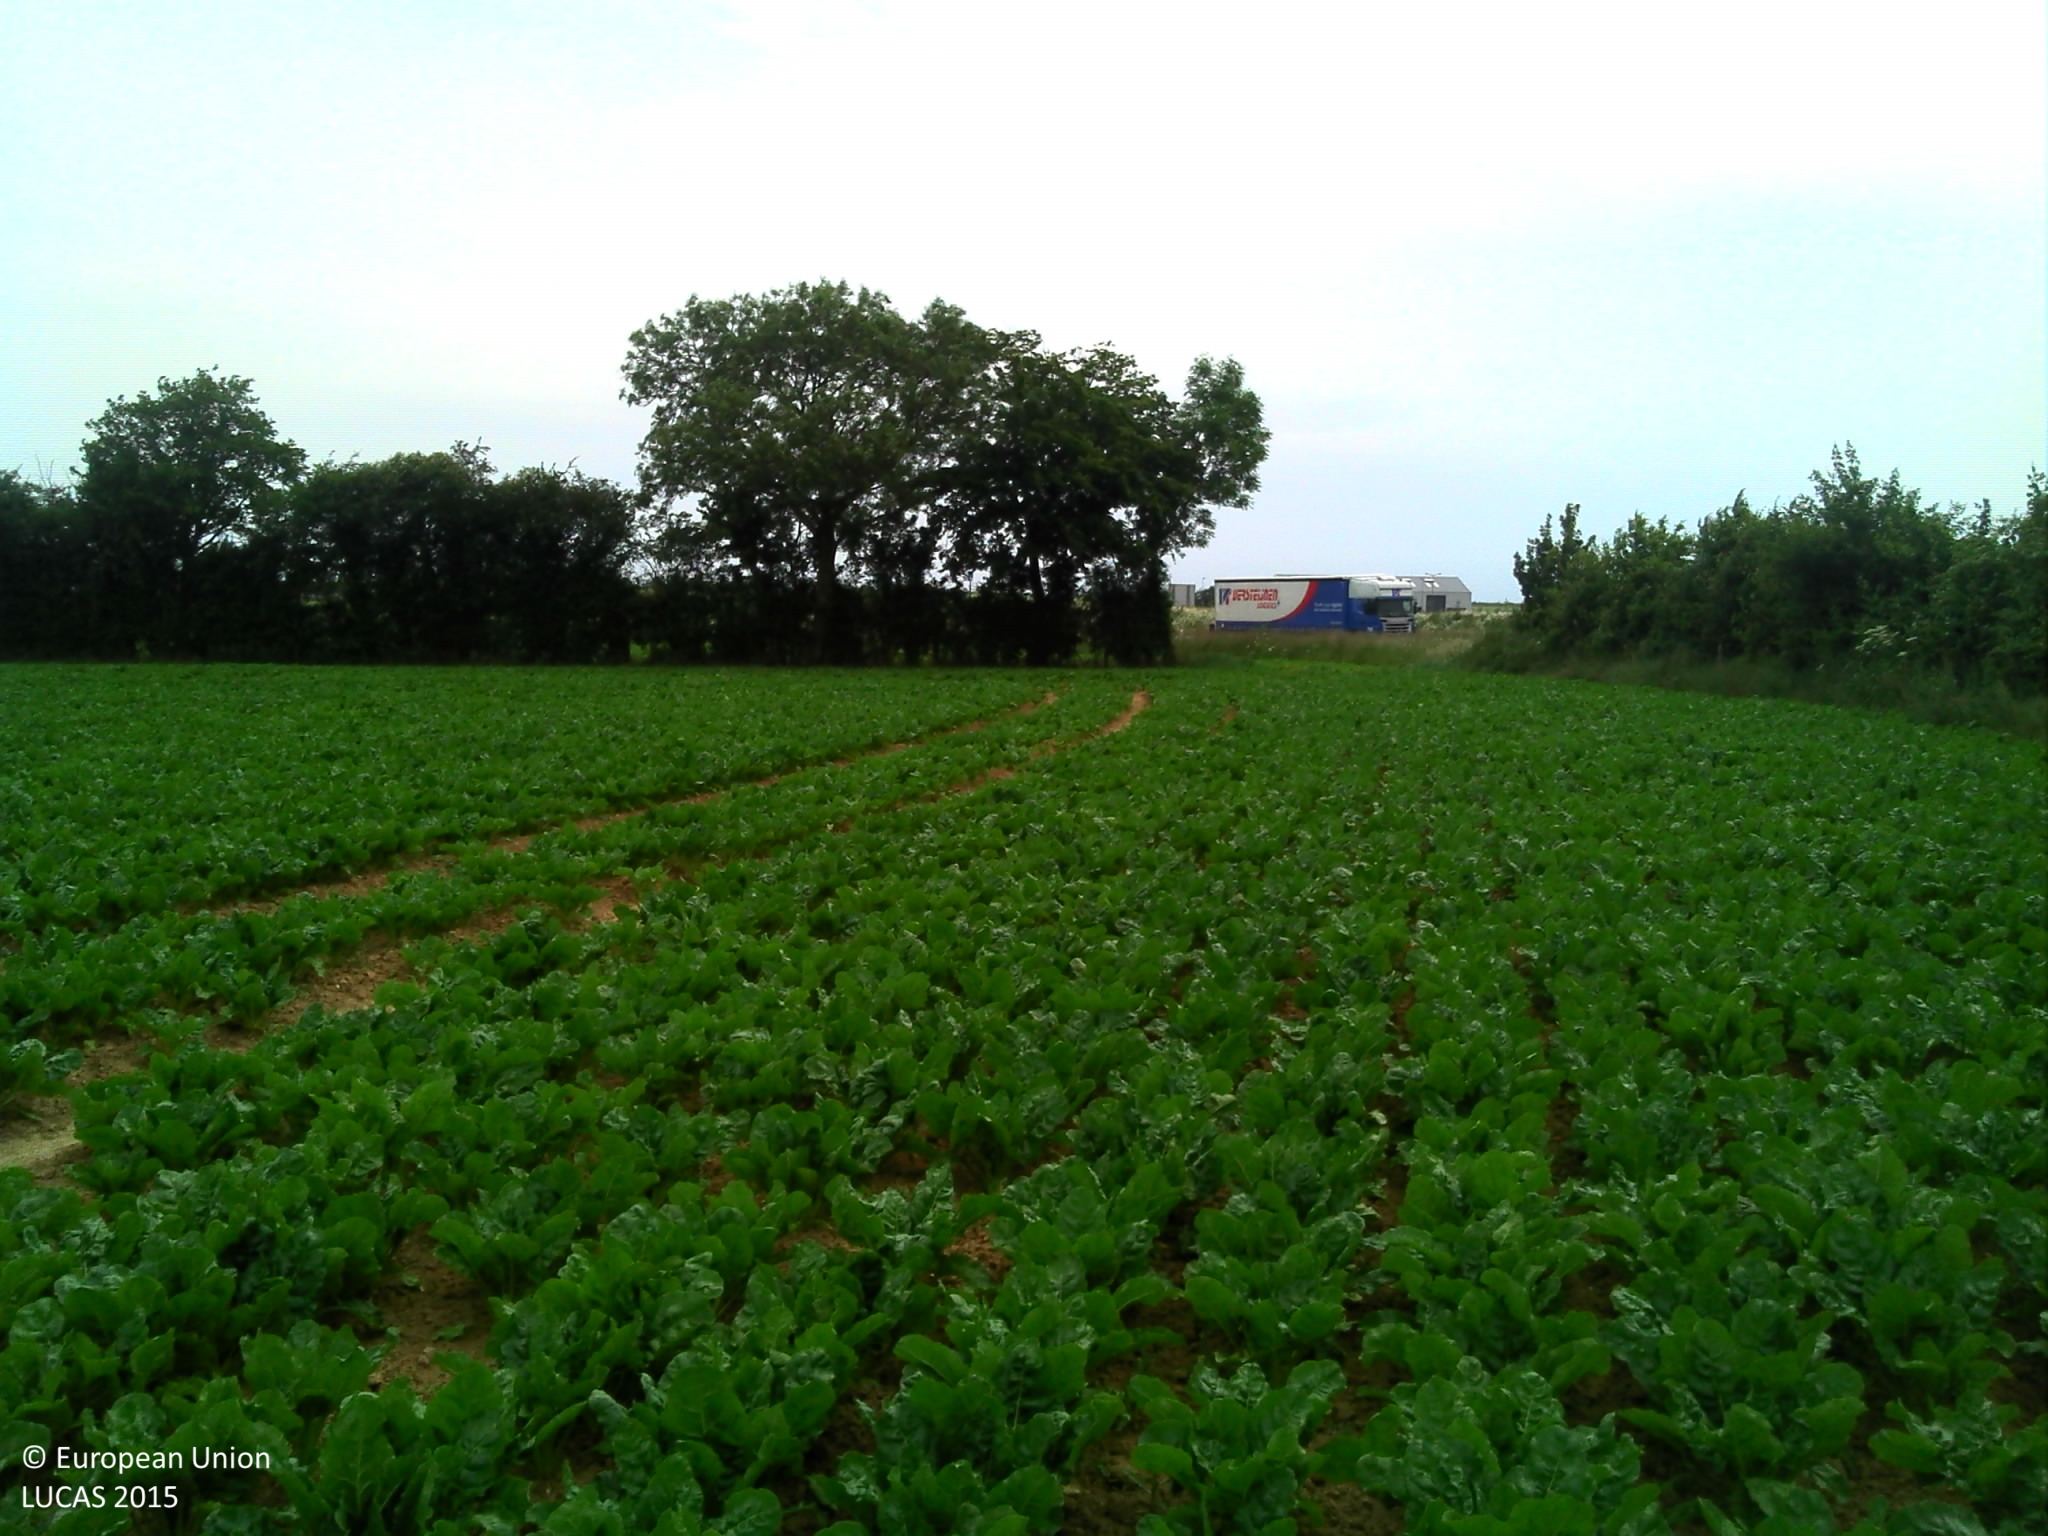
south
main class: Cropland
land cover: Sugar beet
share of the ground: > 75 %
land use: Agriculture (excluding fallow land and kitchen gardens)
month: June
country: FR
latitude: 48.6366
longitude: 0.1878
